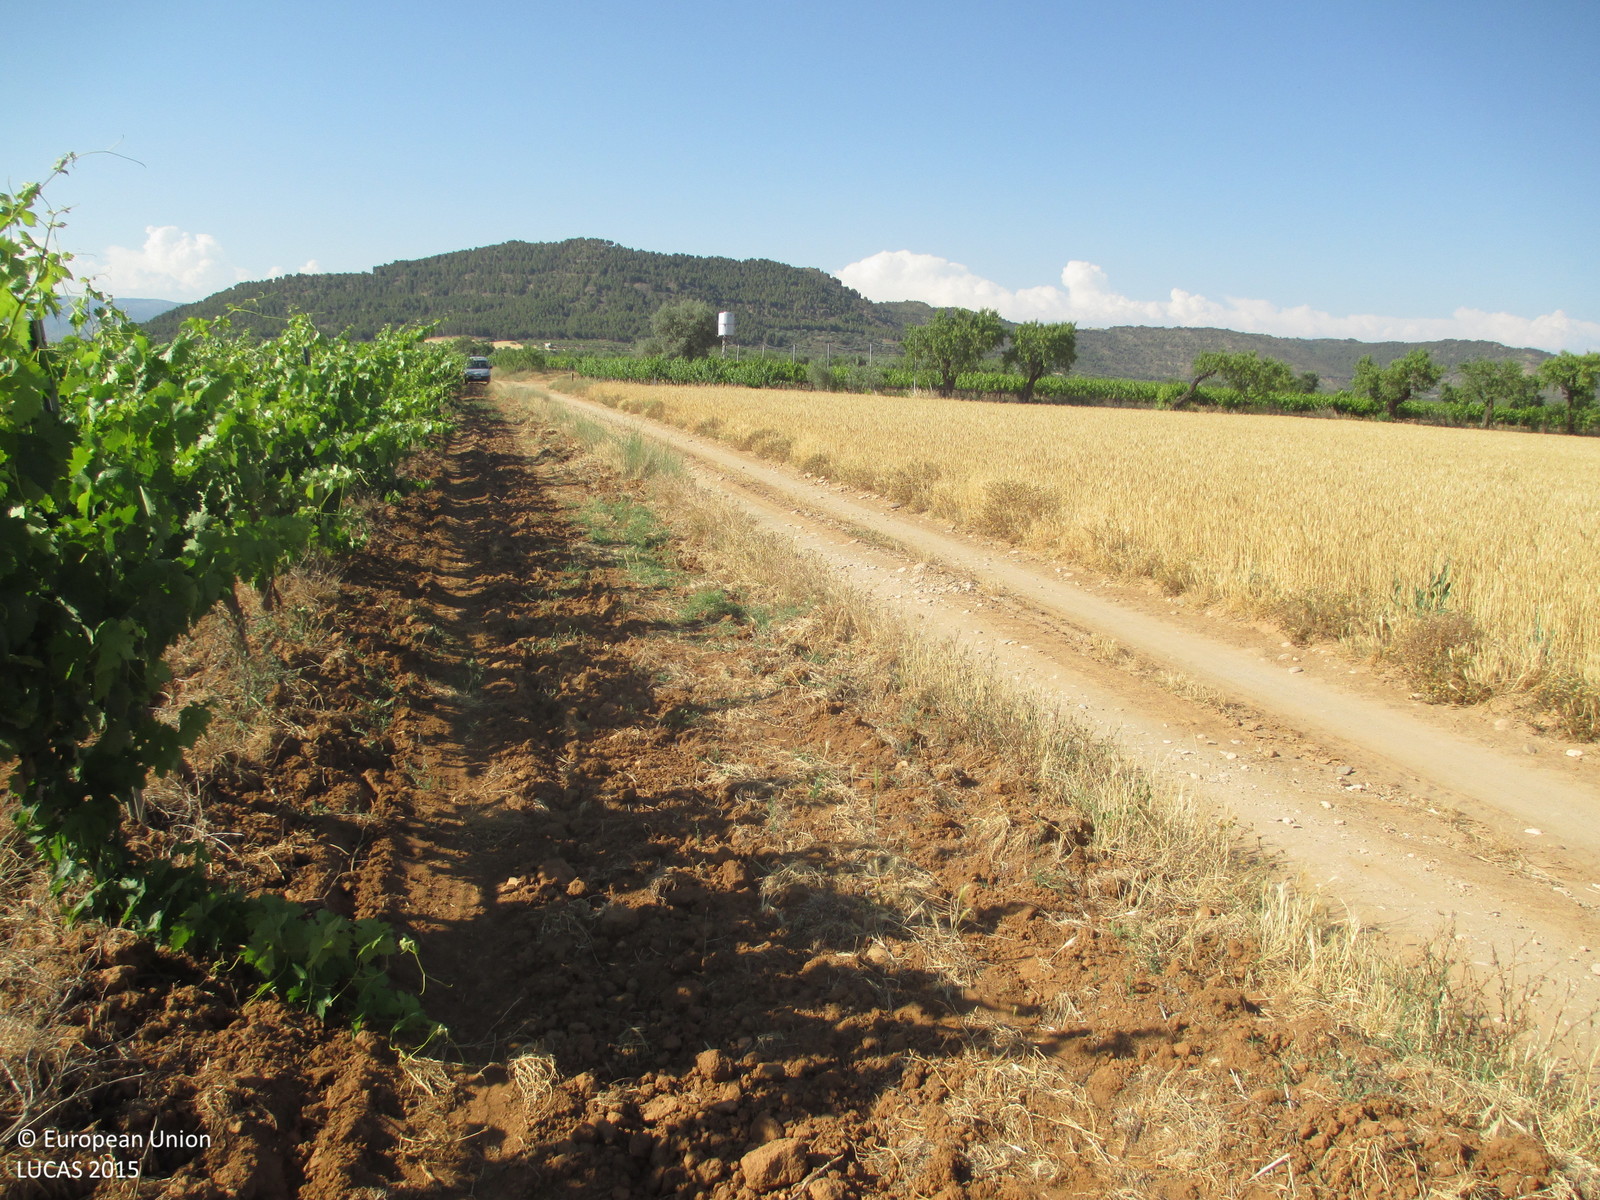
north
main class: Cropland
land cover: Vineyards
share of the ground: > 75 %
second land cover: Other bare soil
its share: > 75 %
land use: Agriculture (excluding fallow land and kitchen gardens)
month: June
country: ES
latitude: 42.0883
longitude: 0.0311
